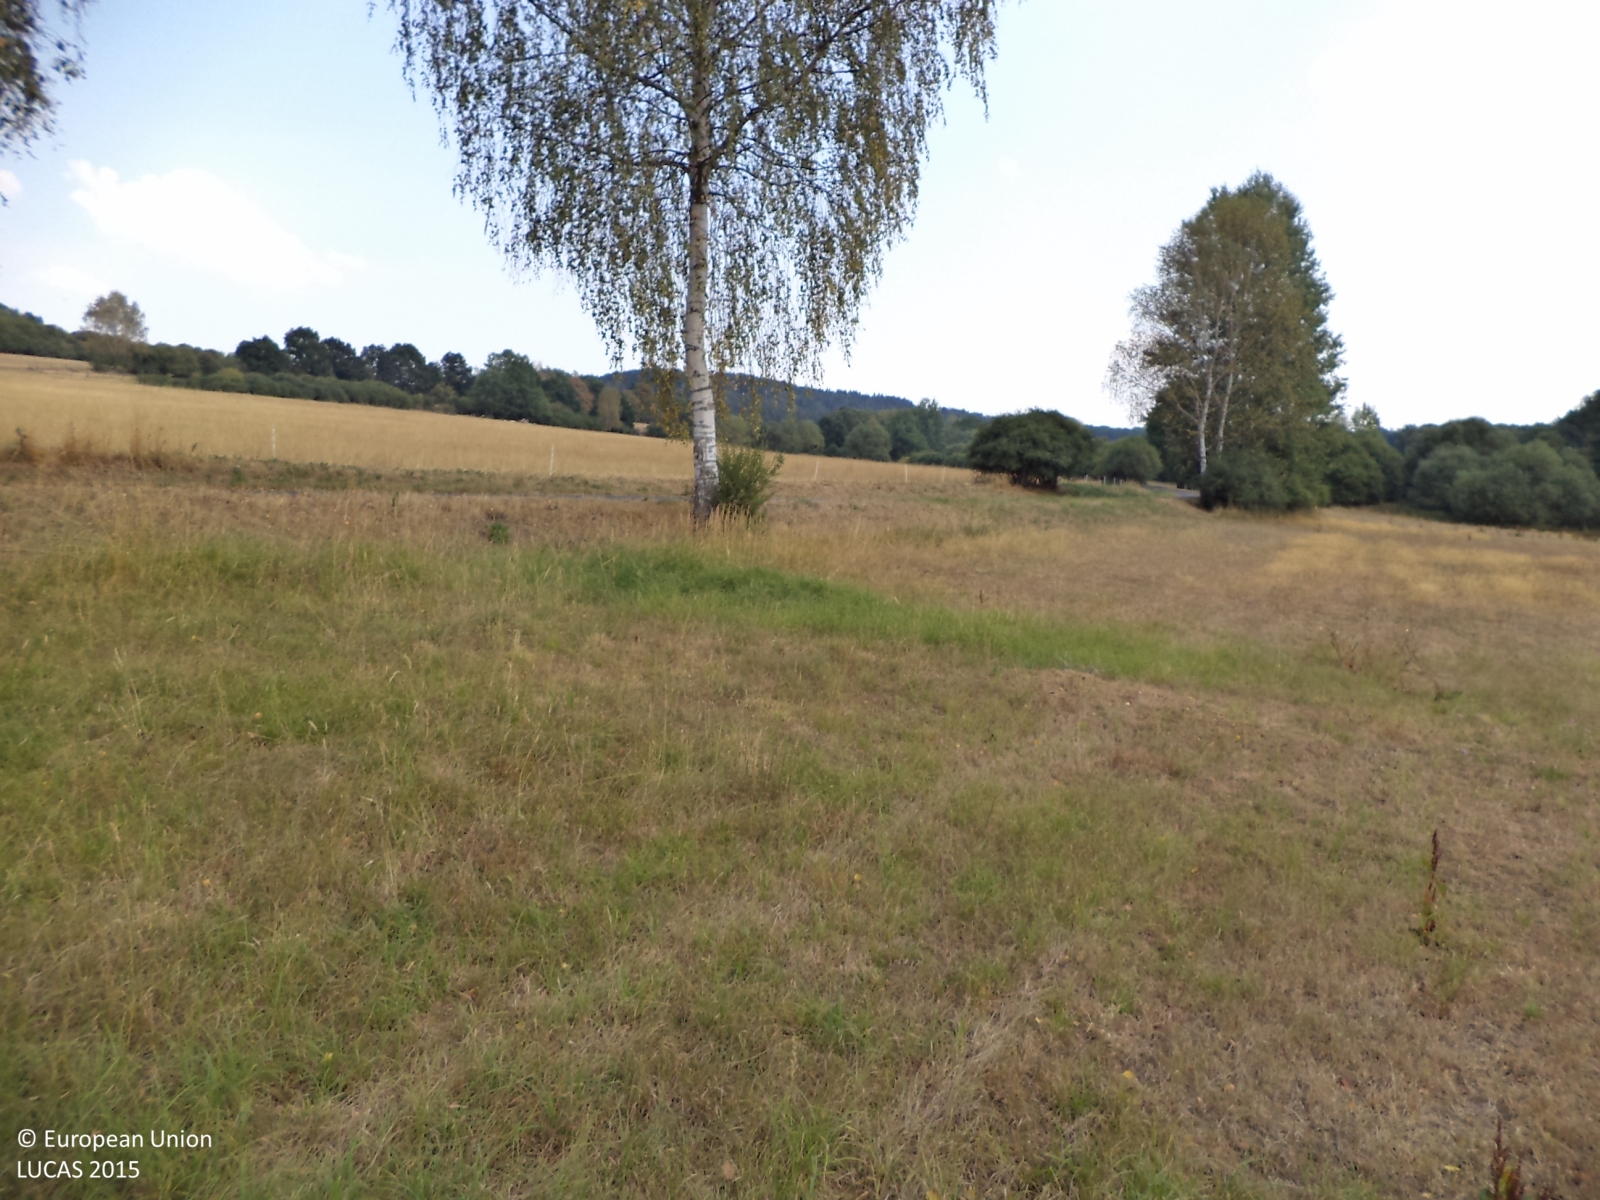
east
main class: Grassland
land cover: Grassland without tree/shrub cover
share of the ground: > 75 %
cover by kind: herbaceous plants 100 %
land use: Agriculture (excluding fallow land and kitchen gardens)
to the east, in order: Grassland without tree/shrub cover; Lines of trees; Grass margins; Paved roads, cycling and walking lanes; Grass margins; Ditches and canals; Grass margins; Fences; Grassland without tree/shrub cover
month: August
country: CZ
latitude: 49.4667
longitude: 14.4583
